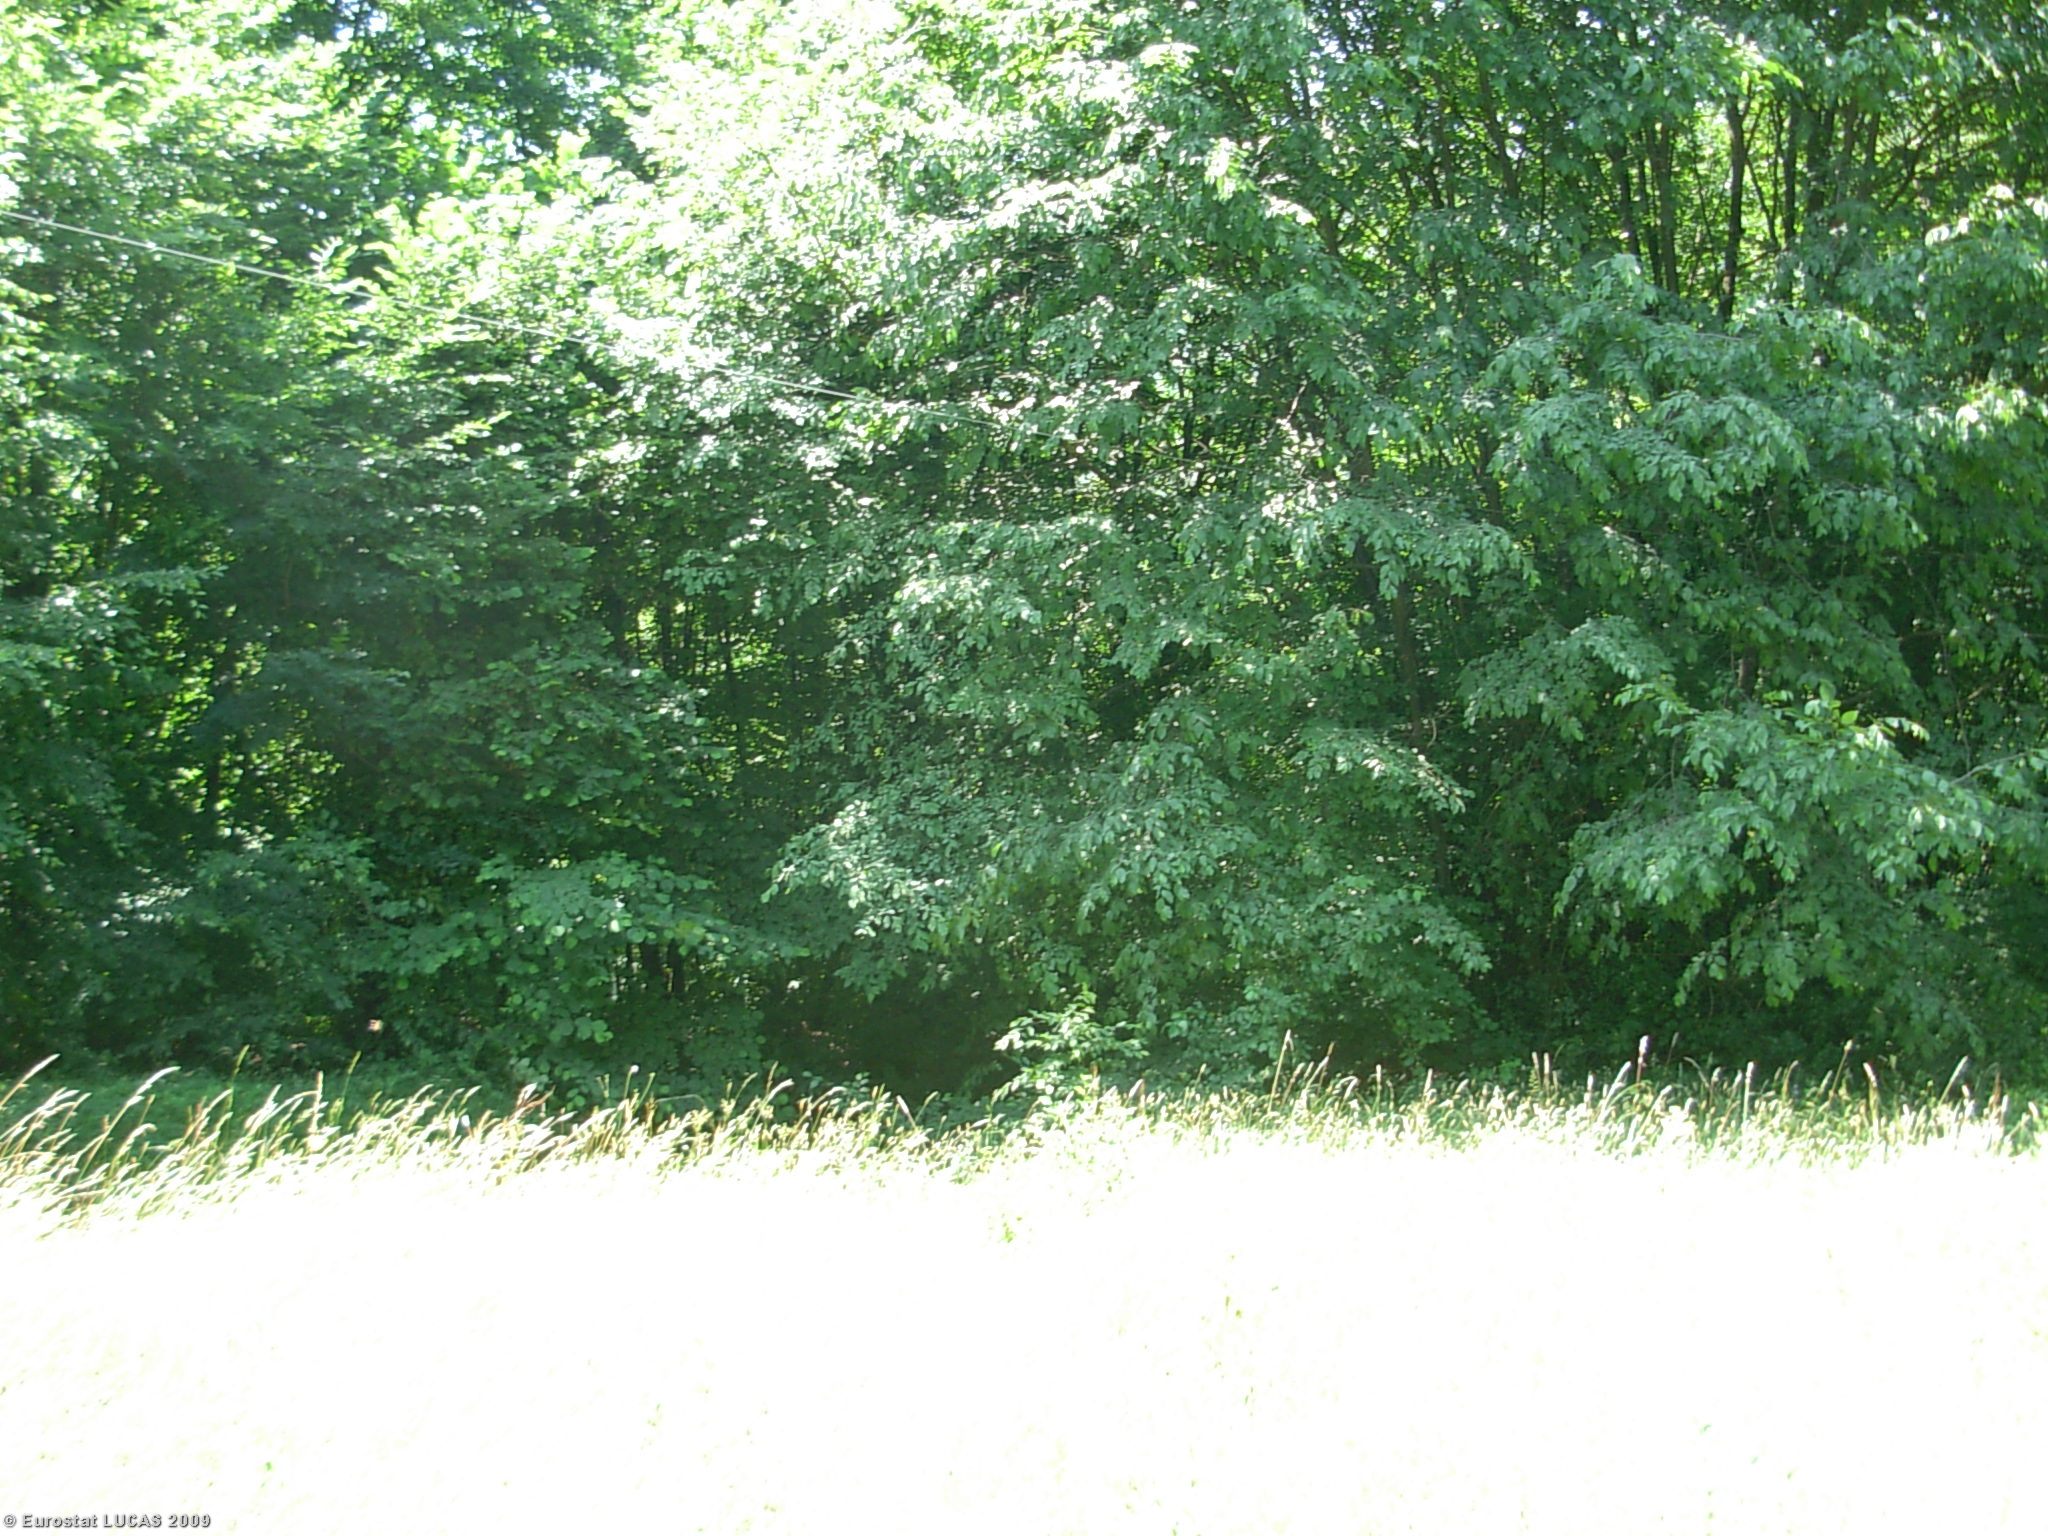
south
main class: Woodland
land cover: Broadleaved woodland
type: mesophytic deciduous forest
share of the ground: > 75 %
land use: Forestry
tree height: > 5 m
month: June
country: IT
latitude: 45.6654
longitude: 10.4998
